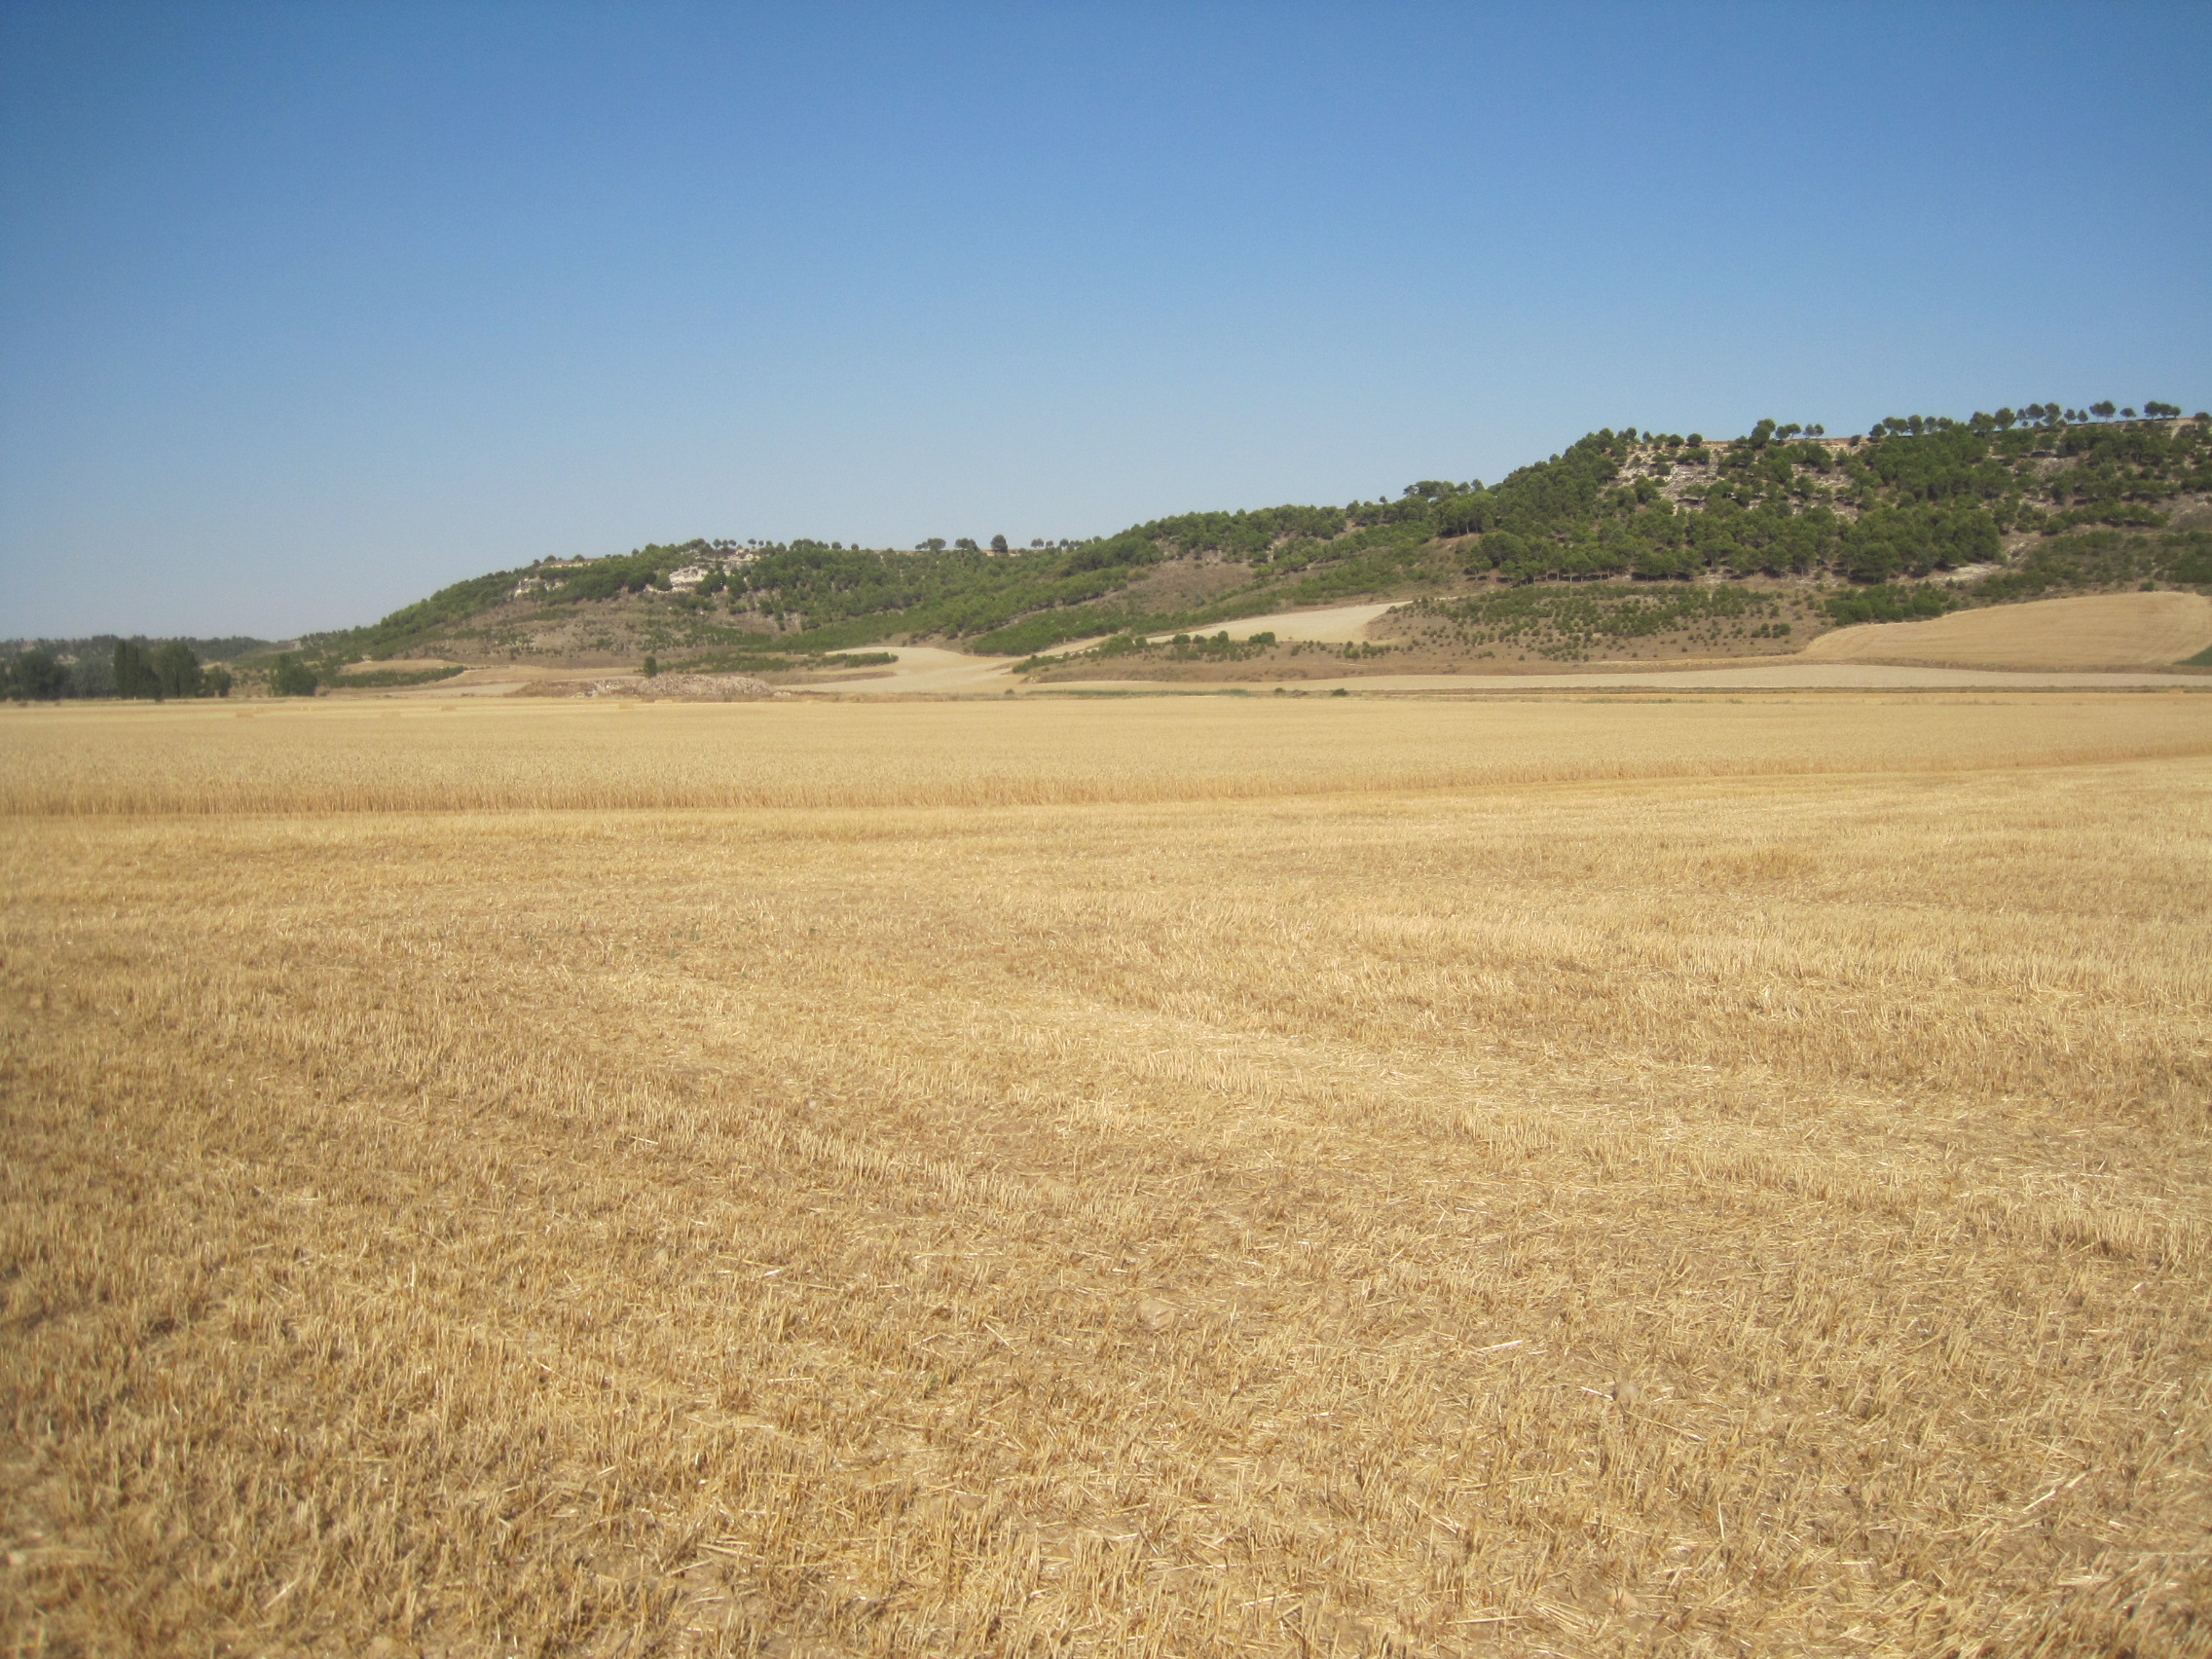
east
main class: Cropland
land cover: Barley
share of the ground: < 10 %
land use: Agriculture (excluding fallow land and kitchen gardens)
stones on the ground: 10 - 25 %
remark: Harvested field
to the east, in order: Barley
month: July
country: ES
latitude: 41.6681
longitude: -5.1748
